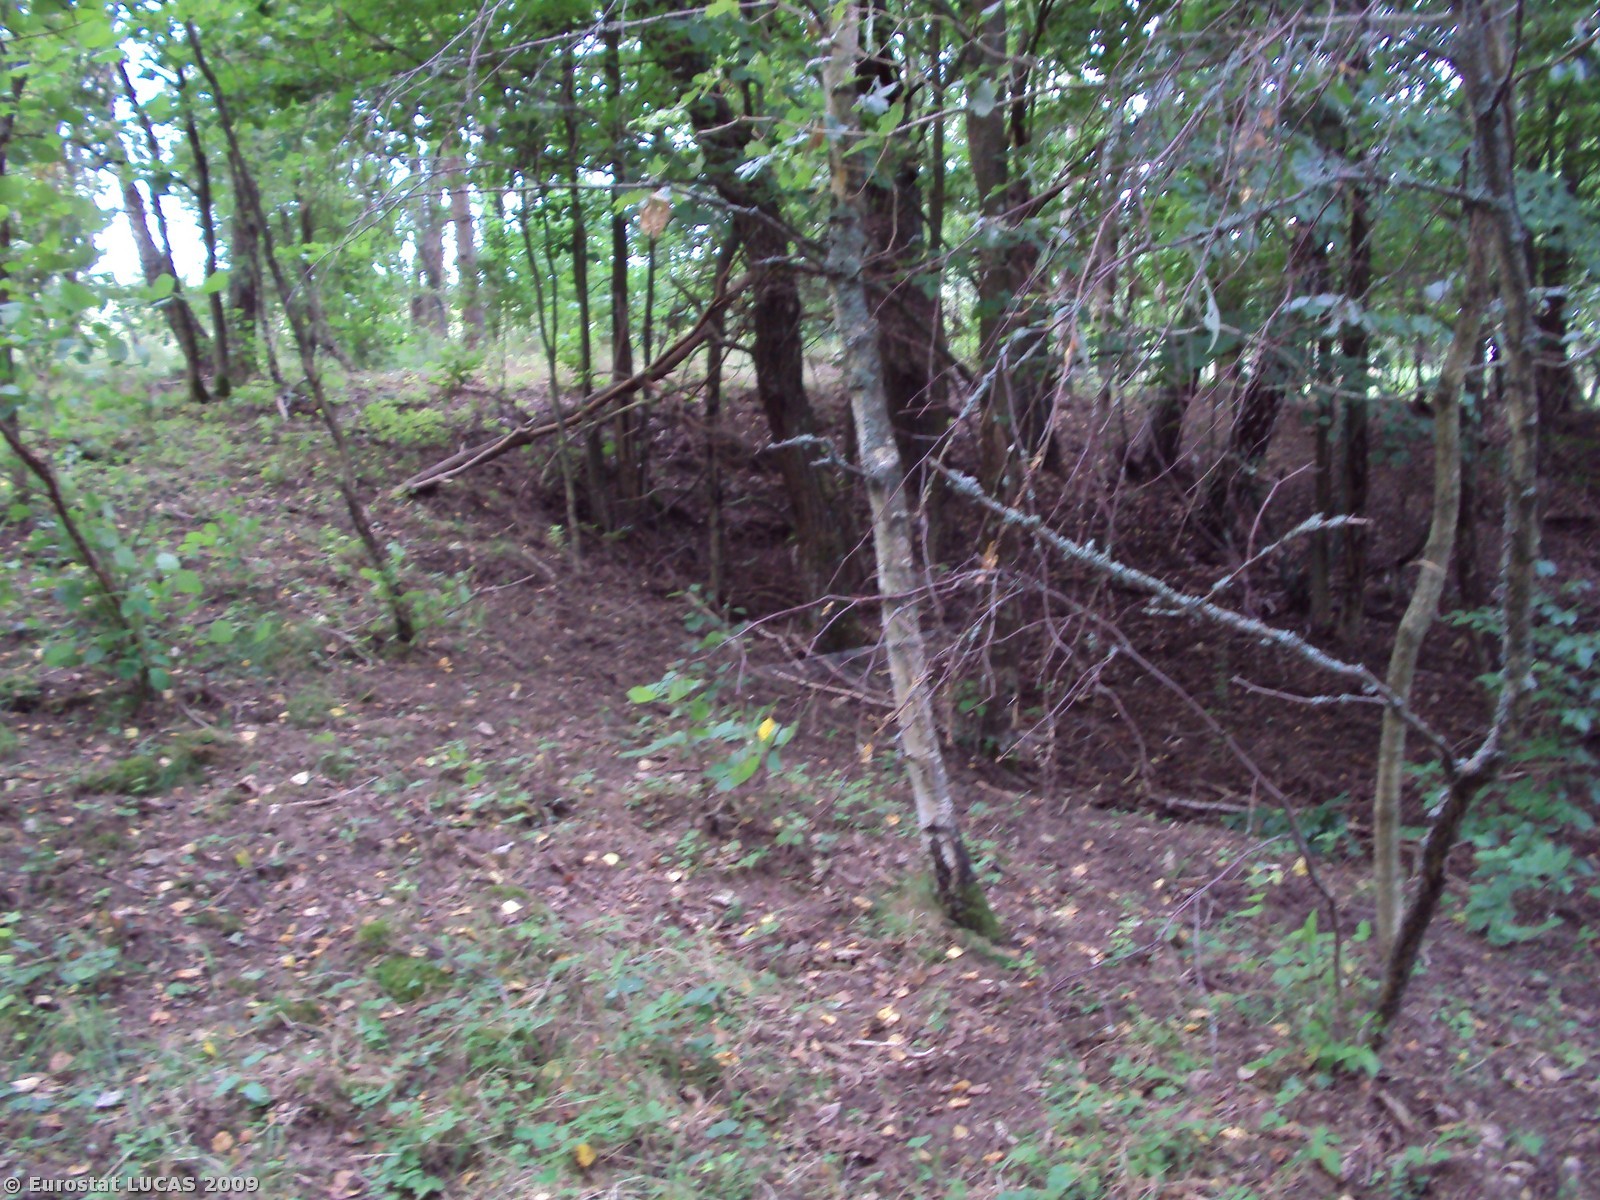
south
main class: Woodland
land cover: Mixed woodland
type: hemiboreal forest and nemoral coniferous forest and mixed broadleaved-coniferous forest
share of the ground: > 75 %
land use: Forestry
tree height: > 5 m
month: August
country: PL
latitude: 53.4928
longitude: 16.5941
